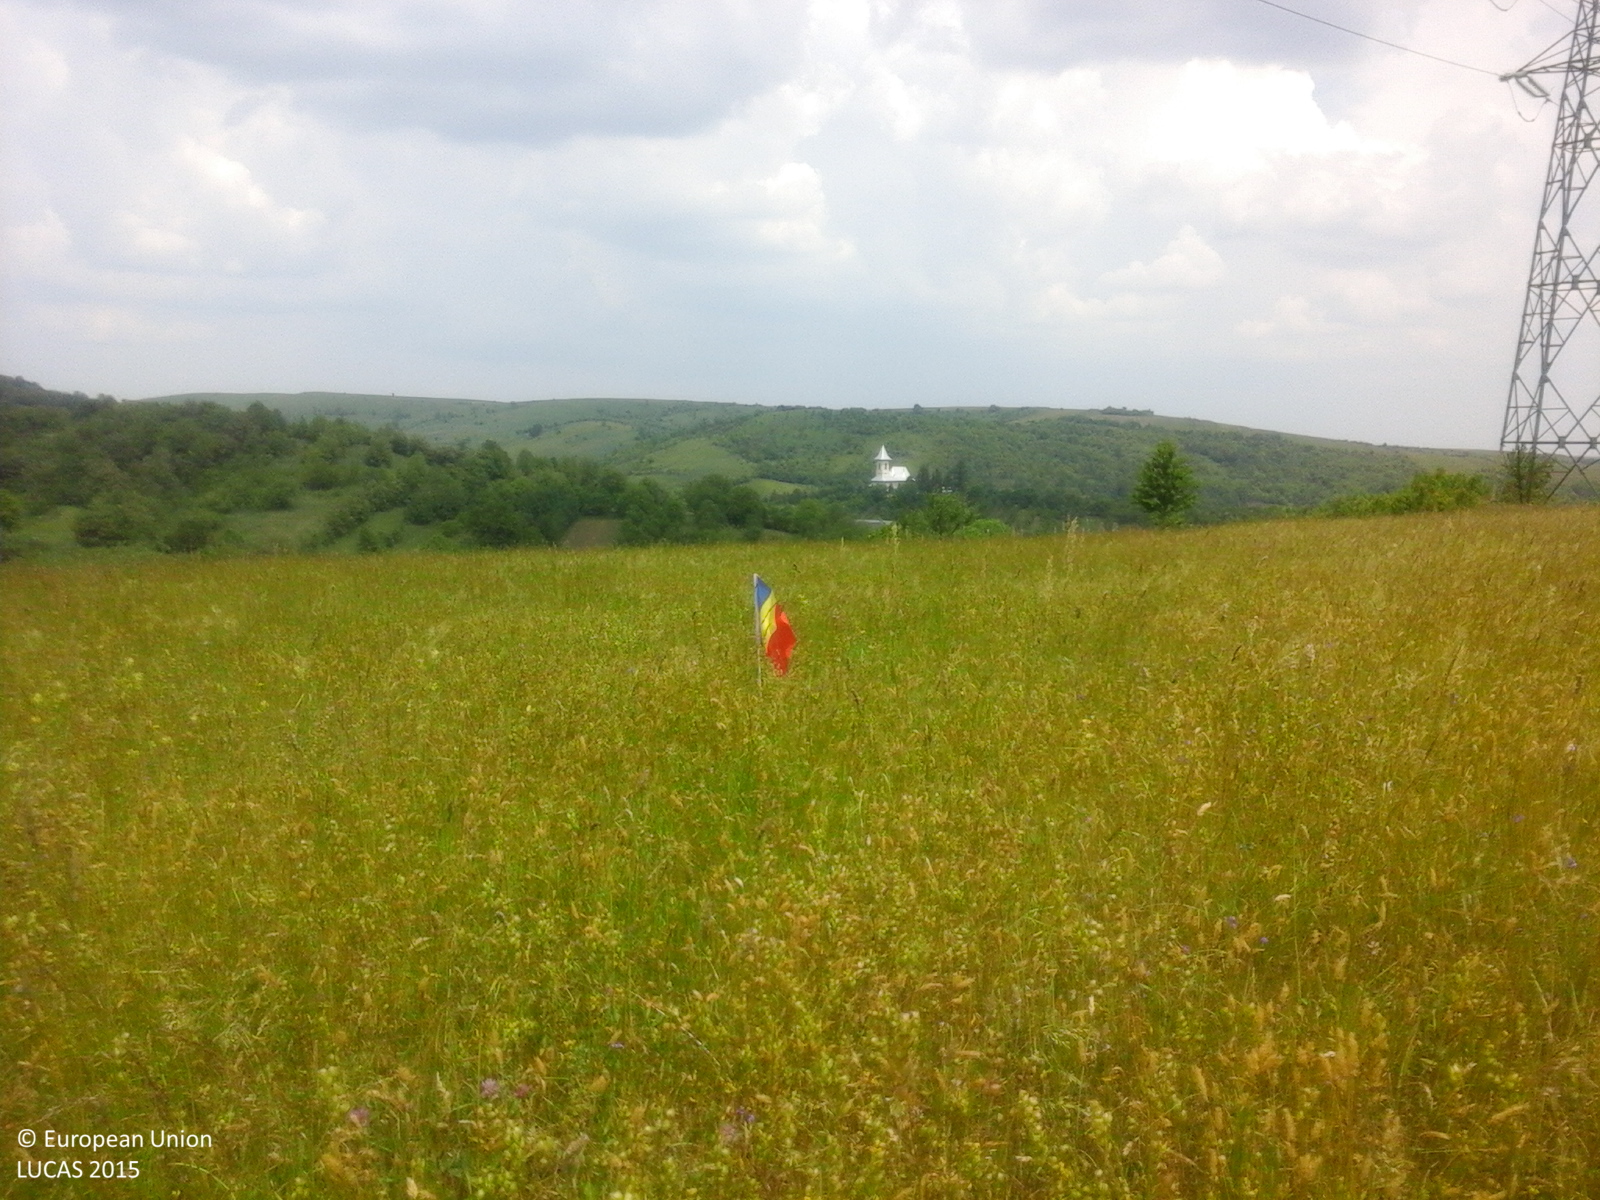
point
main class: Grassland
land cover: Grassland without tree/shrub cover
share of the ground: > 75 %
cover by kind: herbaceous plants 100 %
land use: Agriculture (excluding fallow land and kitchen gardens)
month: June
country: RO
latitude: 46.5031
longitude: 26.5413
